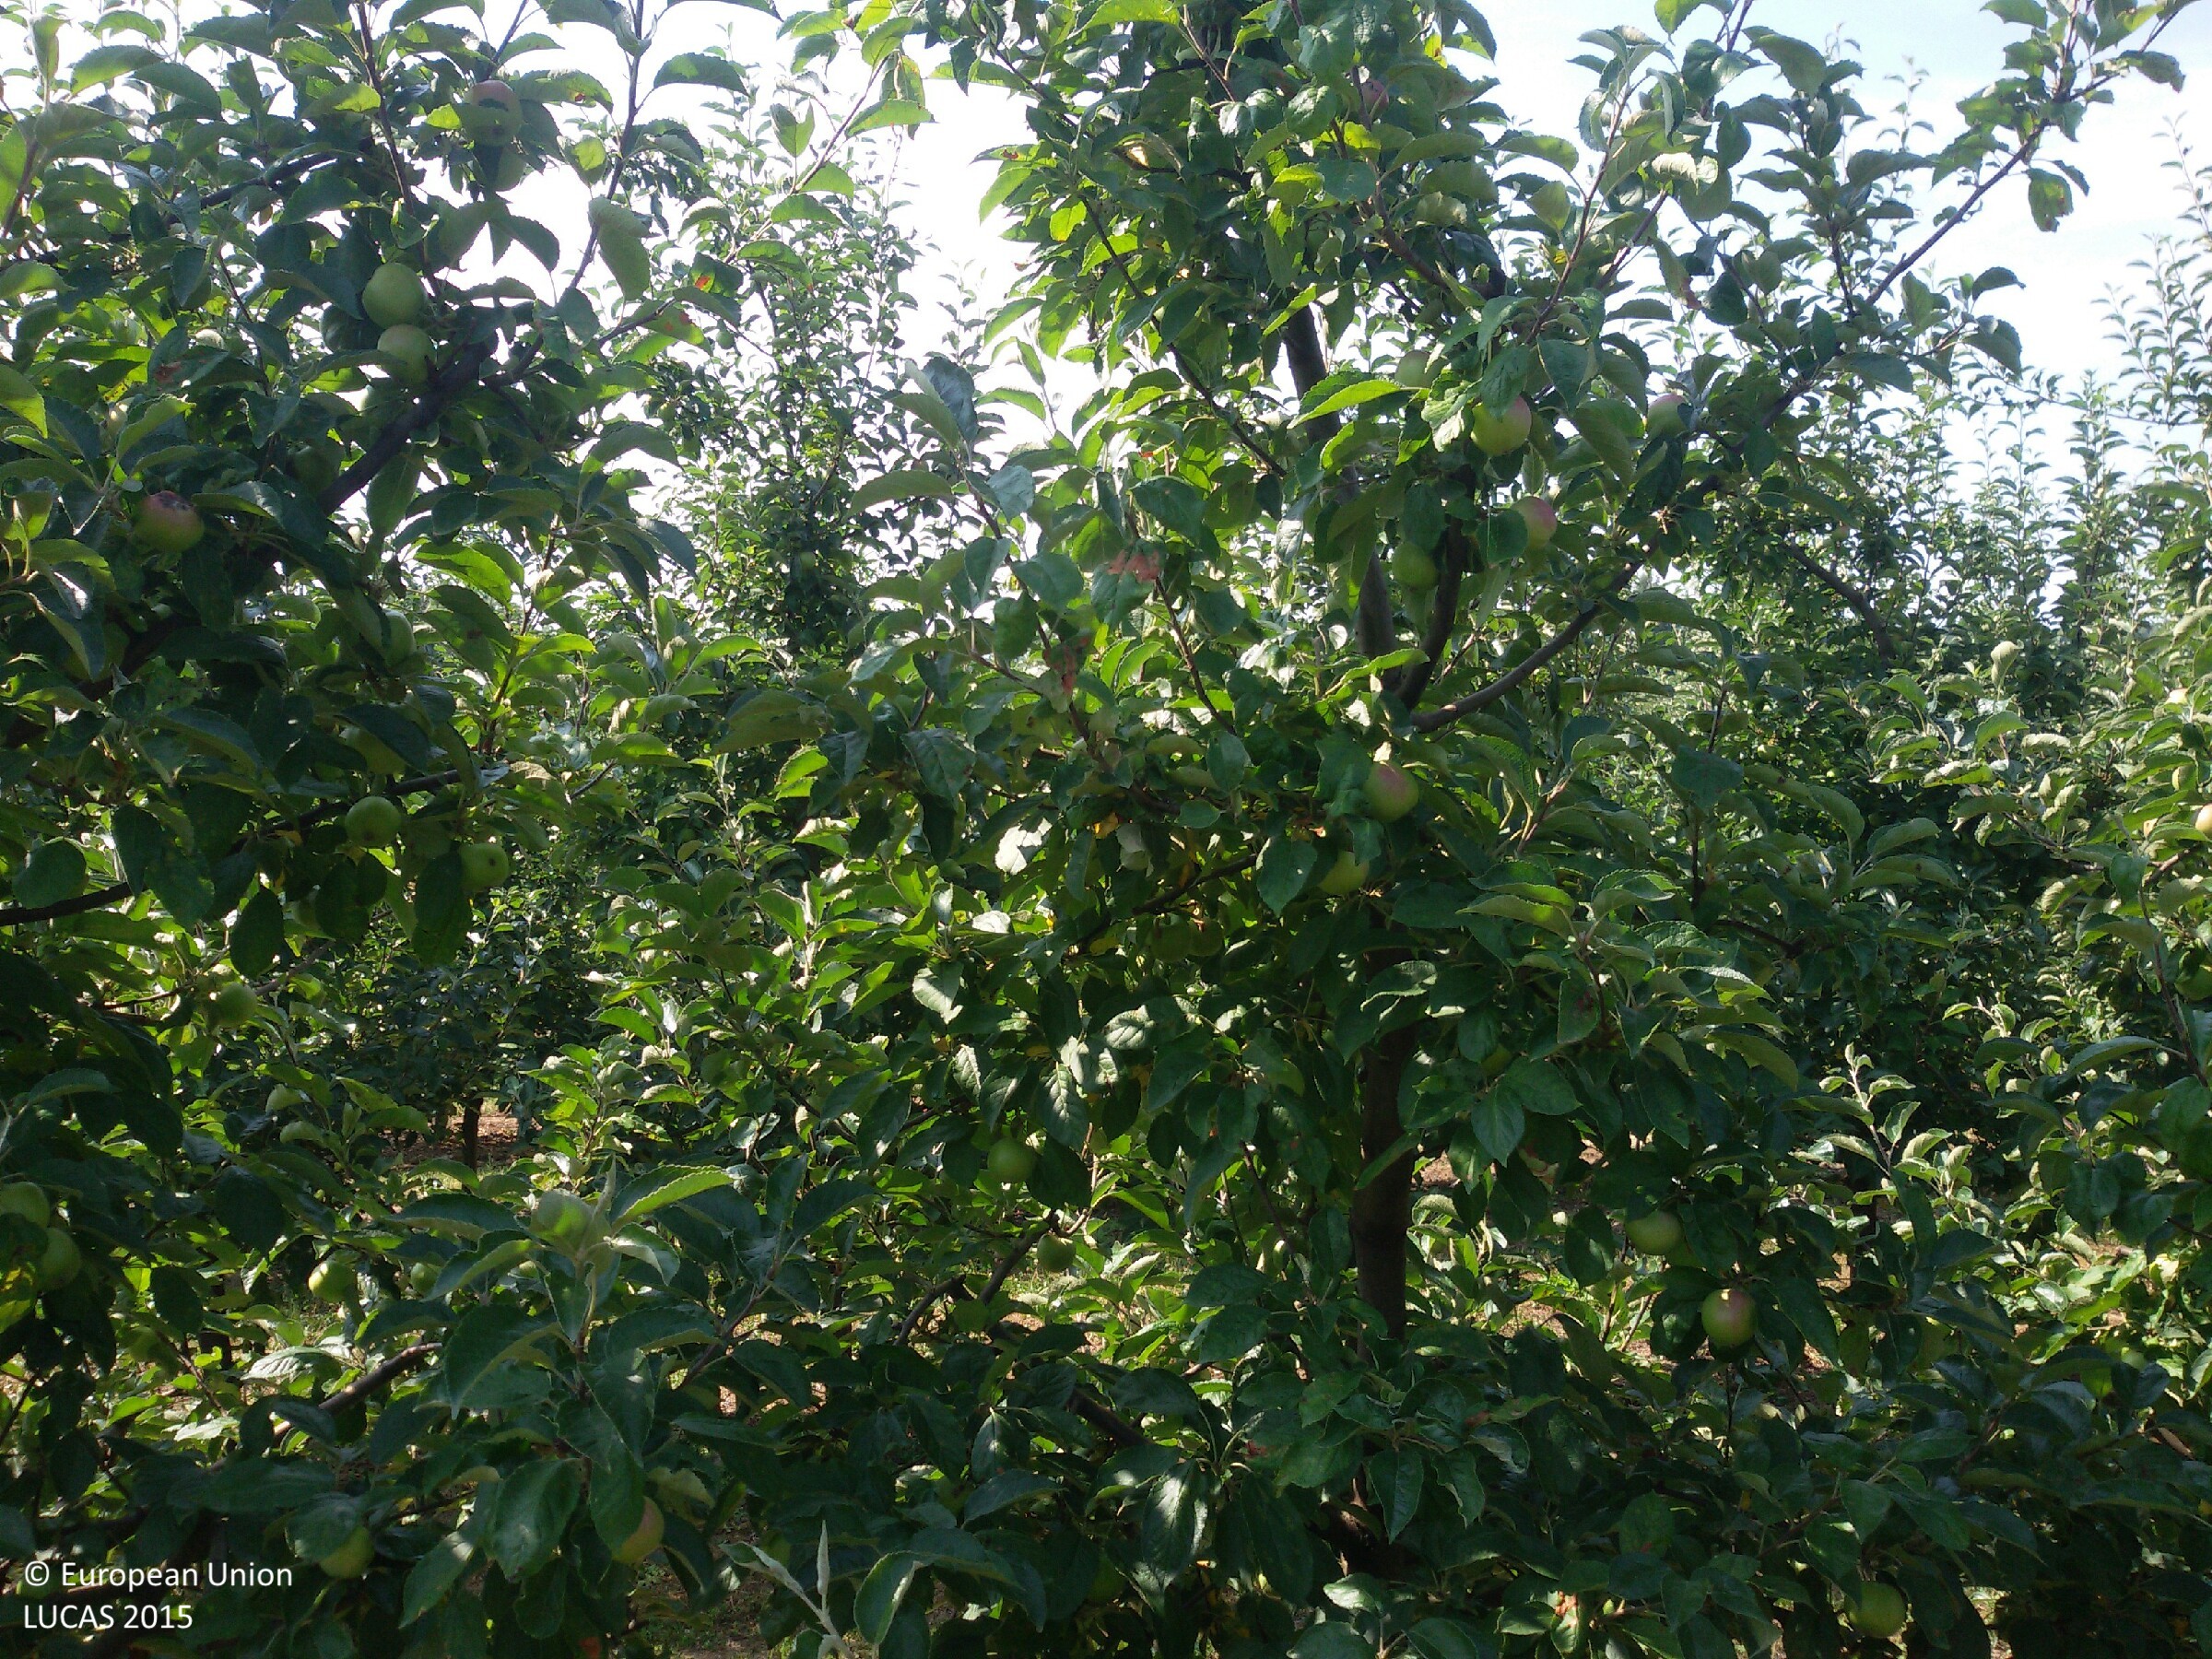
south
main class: Cropland
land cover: Apple fruit
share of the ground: 50 - 75 %
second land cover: Grassland without tree/shrub cover
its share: 50 - 75 %
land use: Agriculture (excluding fallow land and kitchen gardens)
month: July
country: PL
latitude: 51.7458
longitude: 20.7154
